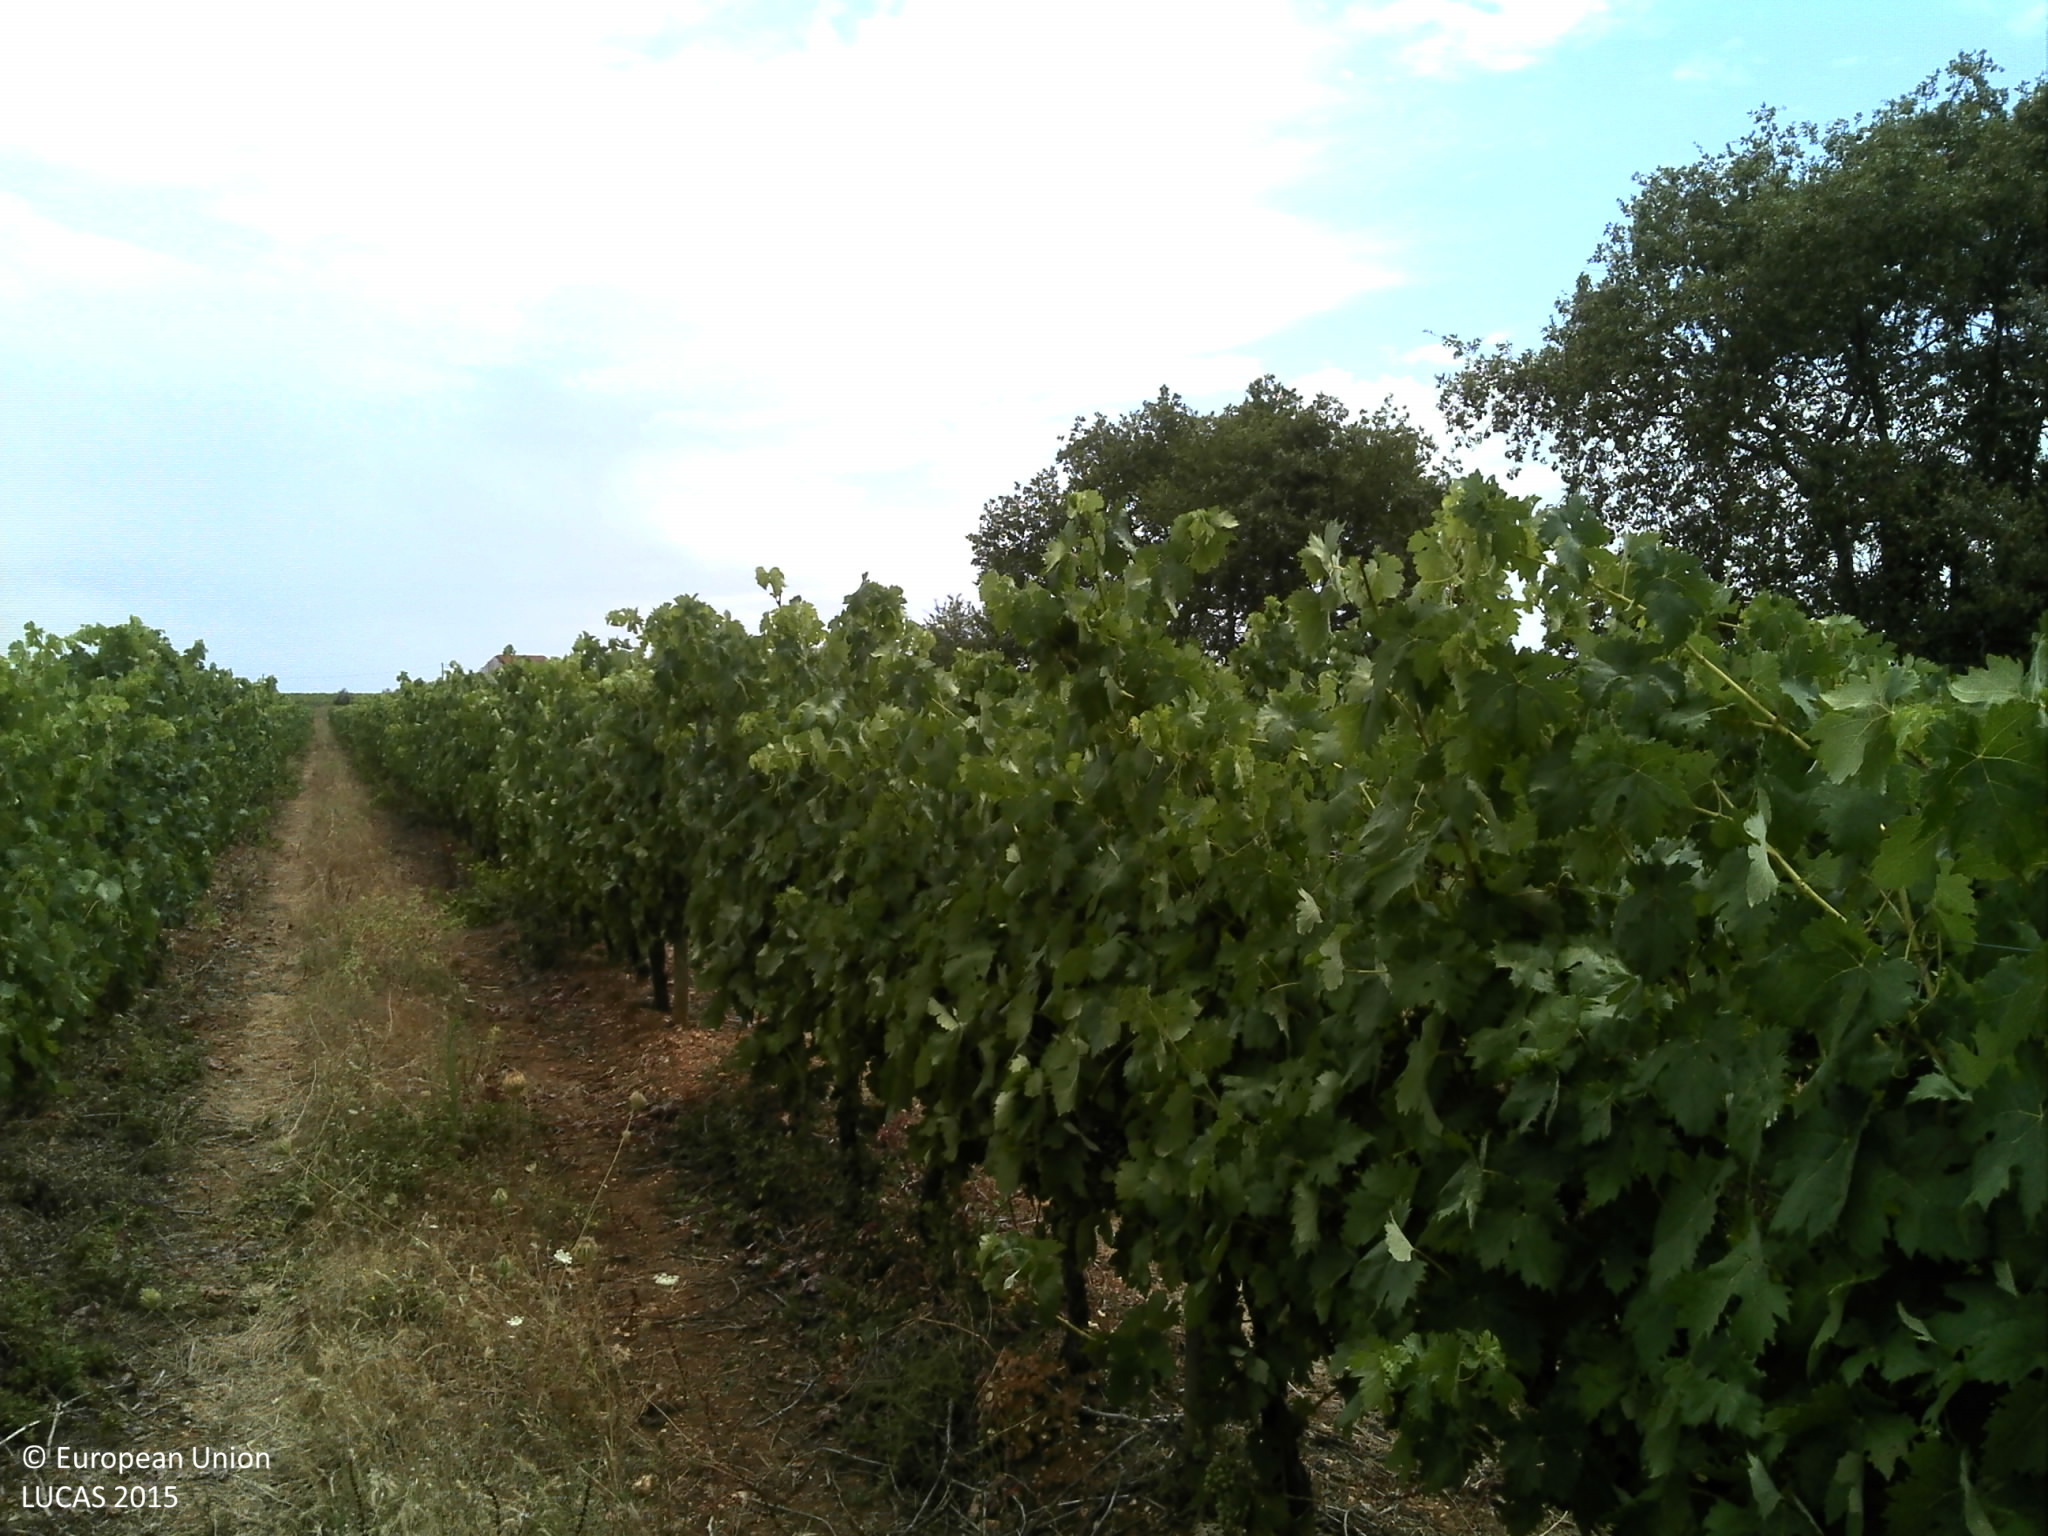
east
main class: Cropland
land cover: Vineyards
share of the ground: 25 - 50 %
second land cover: Other bare soil
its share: > 75 %
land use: Agriculture (excluding fallow land and kitchen gardens)
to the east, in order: Vineyards; Other bare soil; Vineyards; Other bare soil; Abandoned hedges; Fences; Olive groves; Electric lines; Olive groves; Electric lines; Olive groves; Ditches and canals; Paved roads, cycling and walking lanes; Ditches and canals; Dry stone walls; Shruby margins; Olive groves
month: July
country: PT
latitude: 38.8226
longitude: -7.5311
